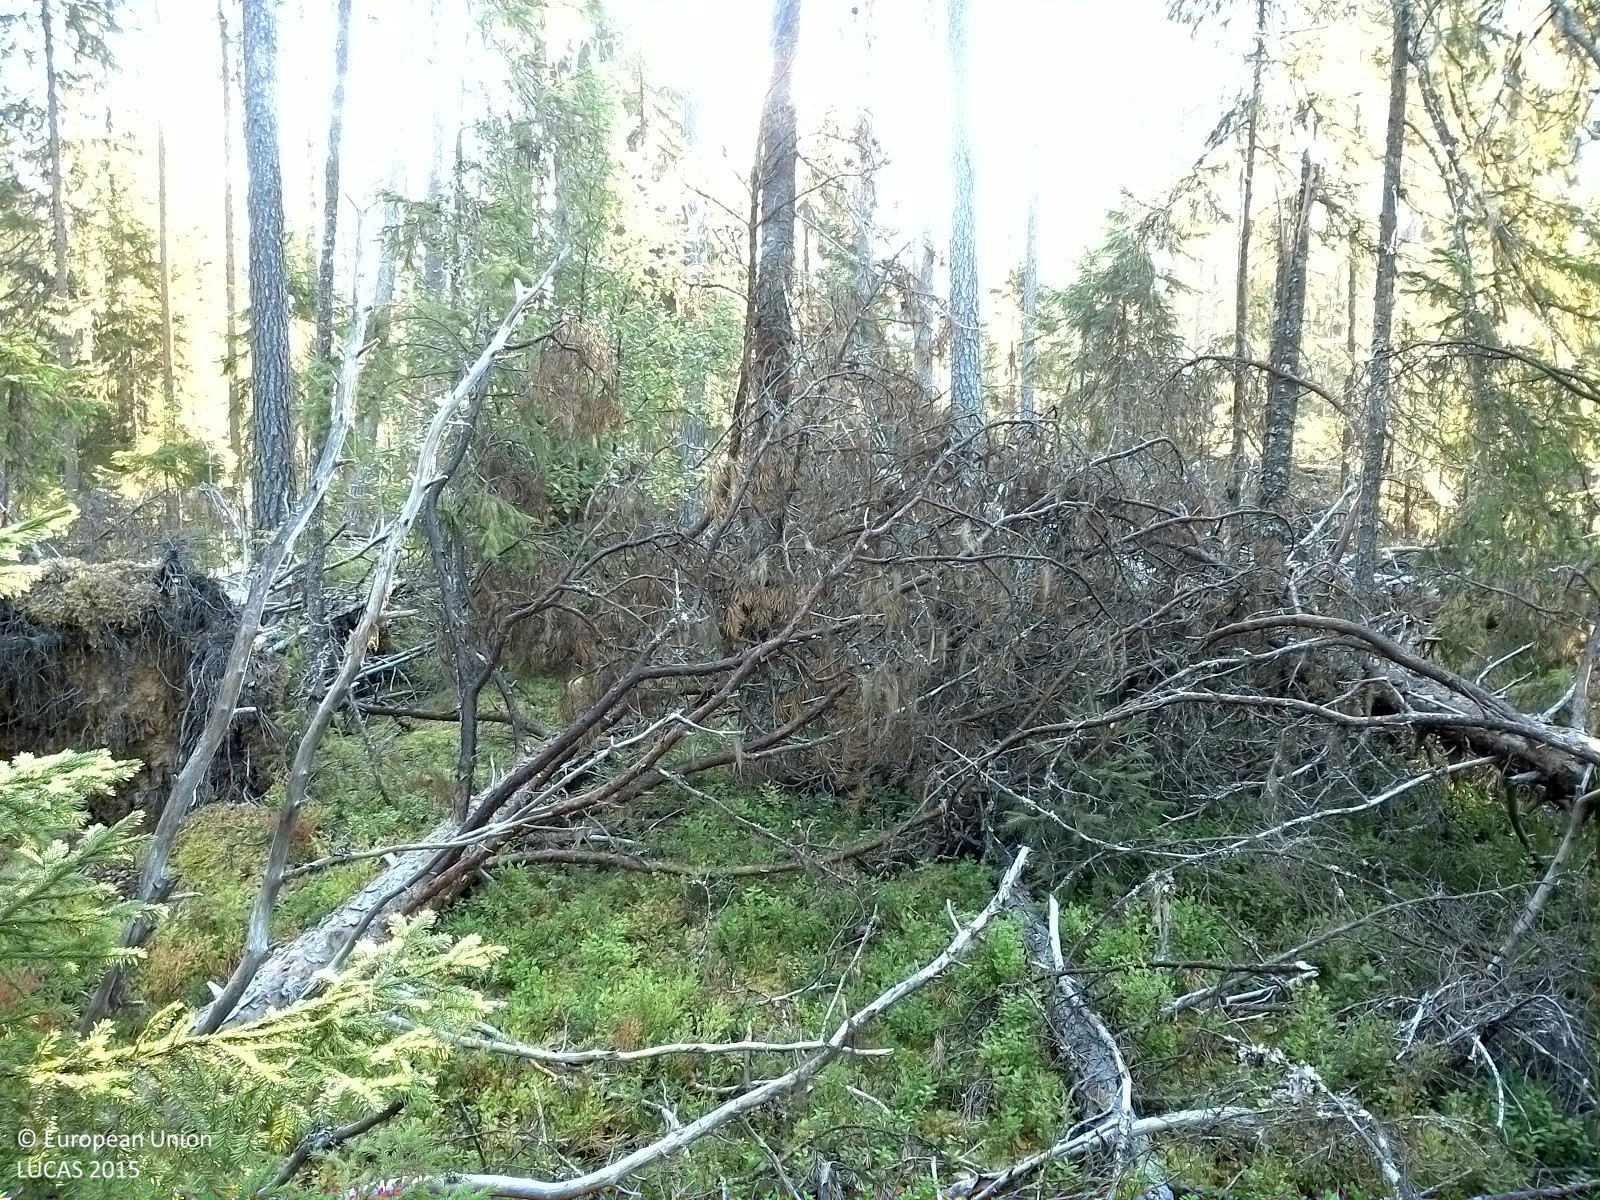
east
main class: Woodland
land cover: Pine dominated coniferous woodland
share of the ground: 25 - 50 %
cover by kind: coniferous forest trees 50 %, lichens and mosses 30 %, shrubs 20 %
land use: Forestry
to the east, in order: Pine dominated coniferous woodland; Paved roads, cycling and walking lanes; Other mixed woodland; Inland fresh water bodies; Pine dominated coniferous woodland; Paved roads, cycling and walking lanes; Pine dominated coniferous woodland; Inland marshes; Pine dominated coniferous woodland
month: September
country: SE
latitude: 62.5983
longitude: 16.0750
